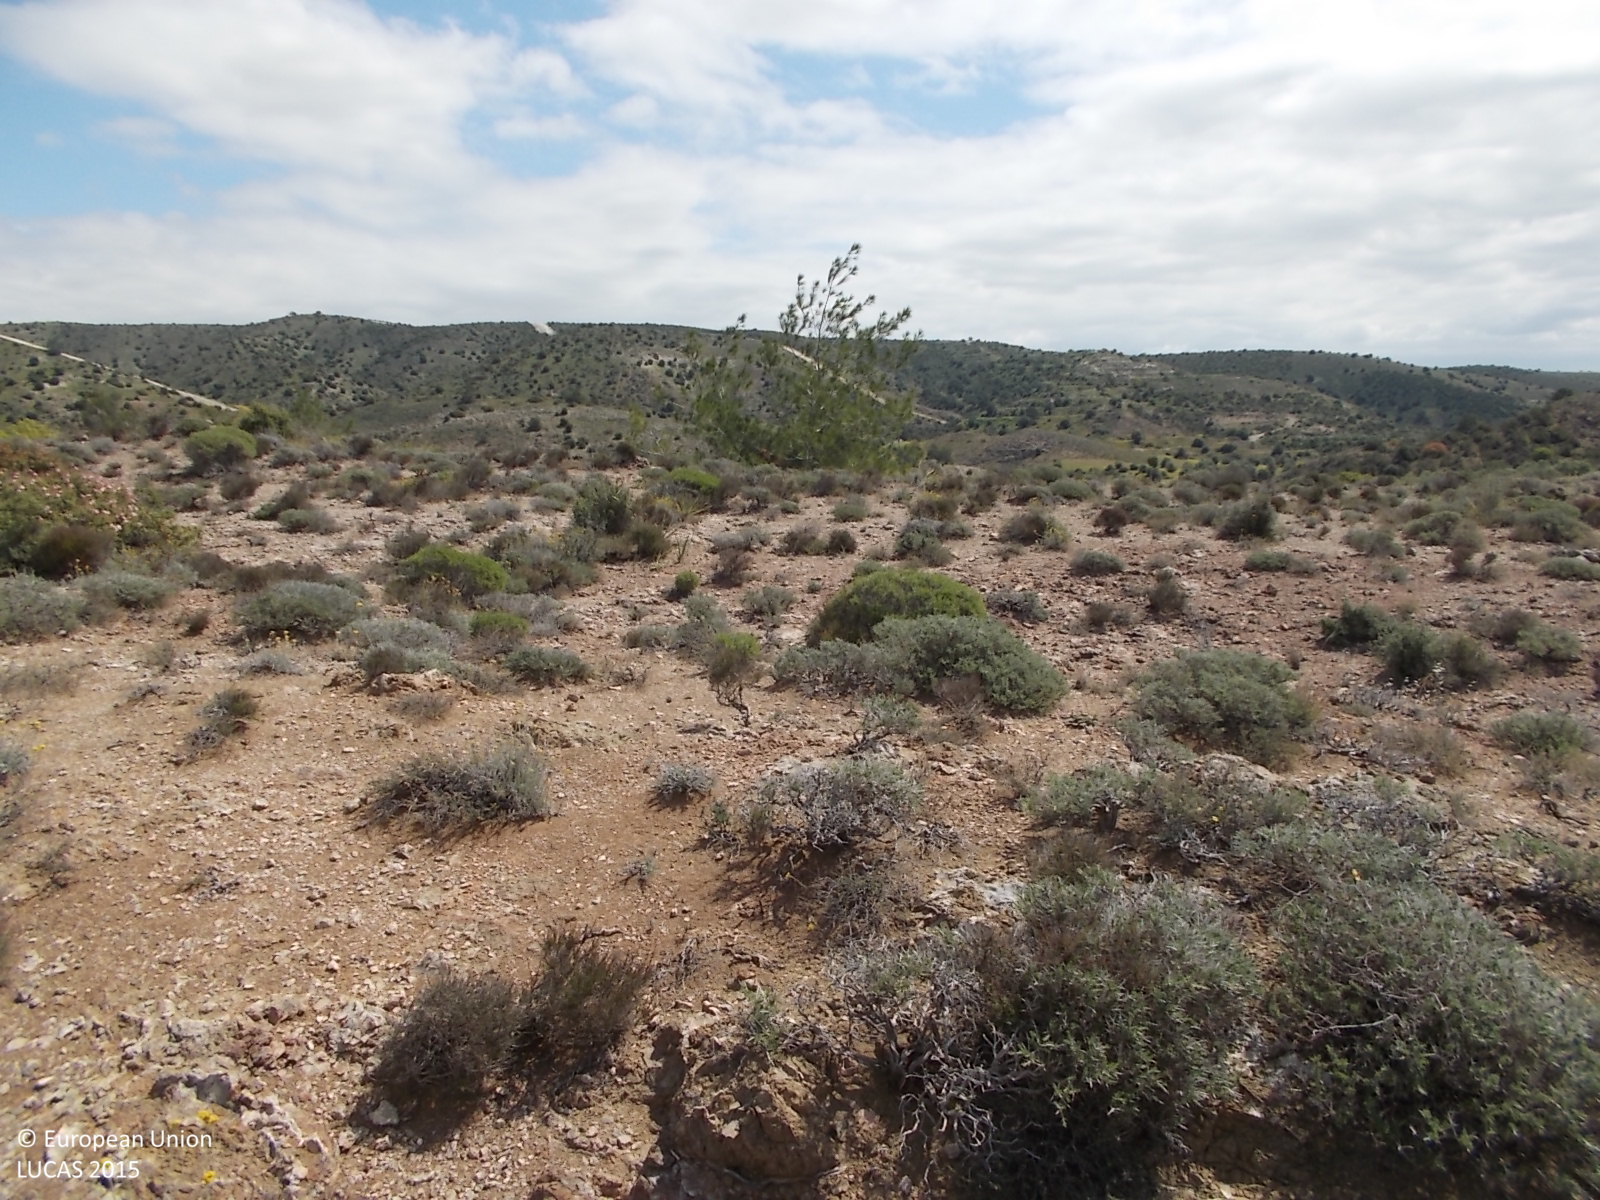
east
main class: Shrubland
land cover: Shrubland without tree cover
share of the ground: 25 - 50 %
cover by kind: shrubs 50 %, unconsolidated bare surface 50 %
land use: Semi-natural and natural areas not in use
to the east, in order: Shrubland without tree cover; Shrubland with sparse tree cover; Tracks; Shrubland without tree cover; Shrubland with sparse tree cover; Rivers and streams; Shrubland without tree cover; Rocks and stones; Spontaneously vegetated surfaces; Shrubland without tree cover; Grassland with sparse tree/shrub cover
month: April
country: CY
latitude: 34.8816
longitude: 33.4598
